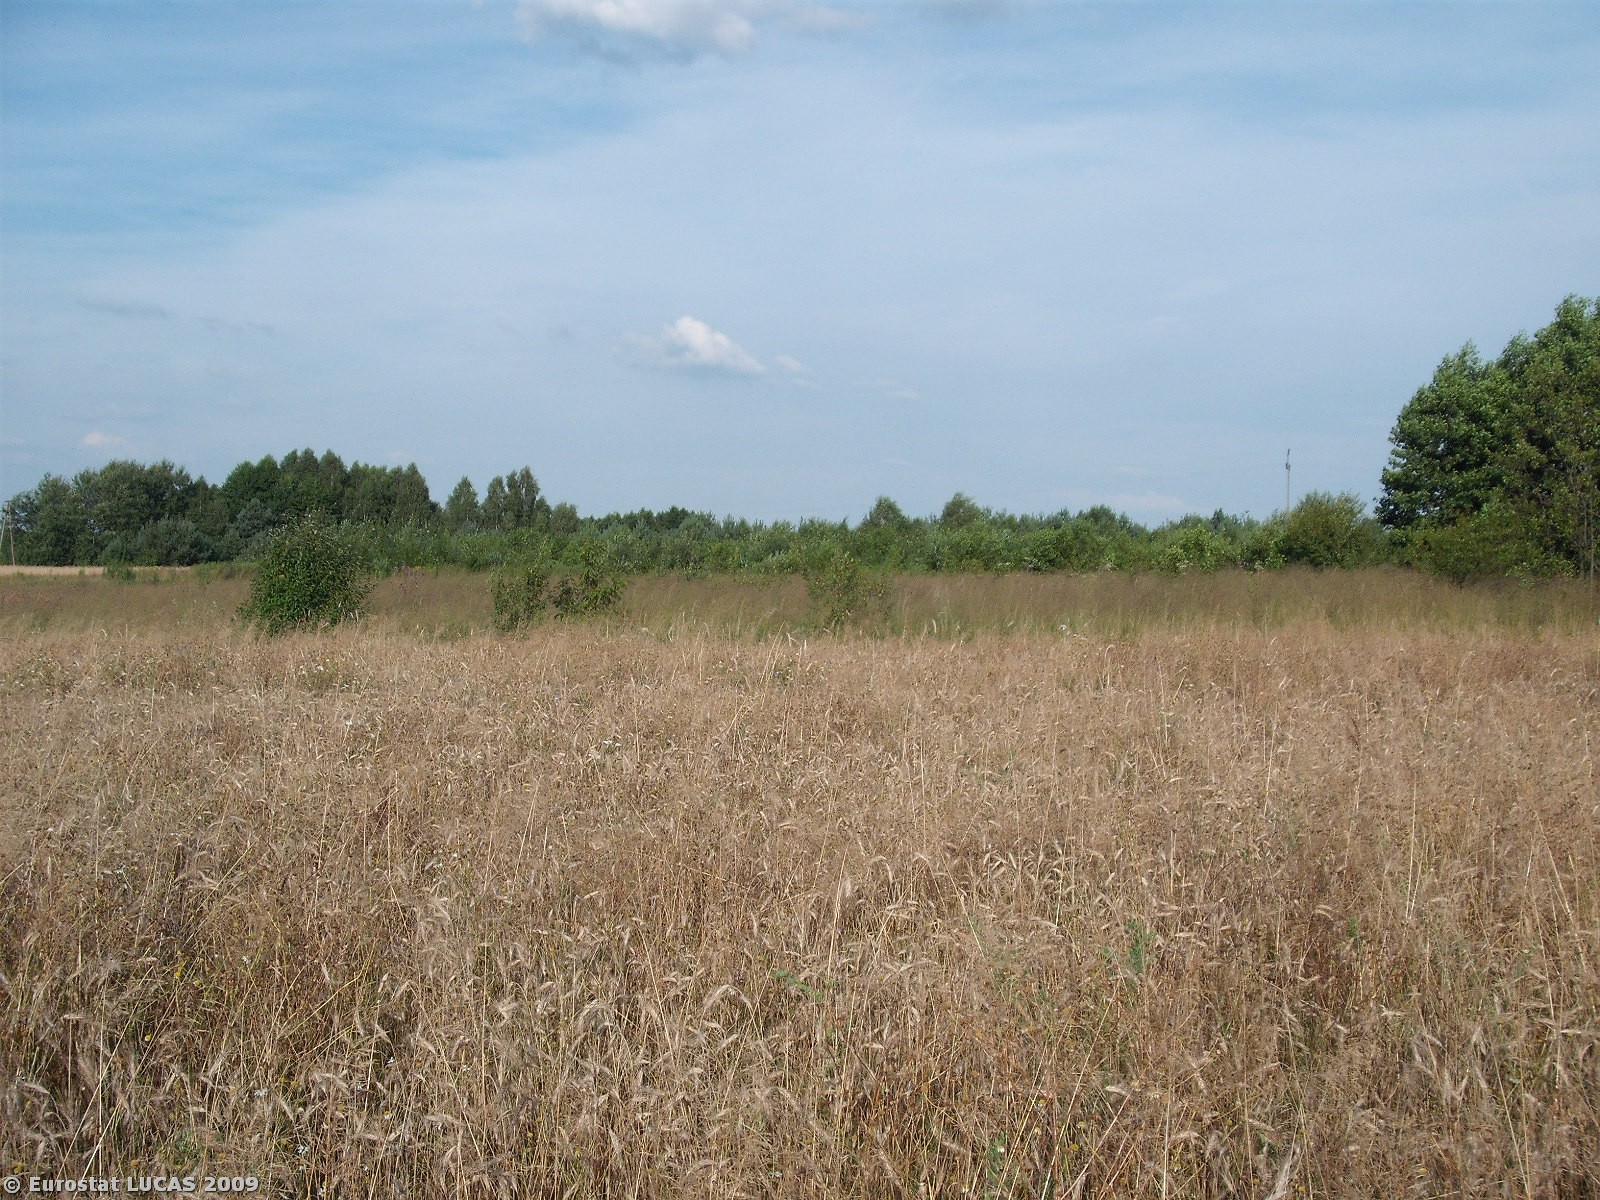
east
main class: Cropland
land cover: Triticale
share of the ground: > 75 %
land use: Agriculture (excluding fallow land and kitchen gardens)
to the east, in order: Triticale; Grass margins; Rye; Tracks; Grassland with sparse tree/shrub cover; Triticale; Tracks; Grassland without tree/shrub cover; Broadleaved woodland; Grassland without tree/shrub cover; Rye; Electric lines; Rye; Coniferous woodland; Grassland without tree/shrub cover
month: July
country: PL
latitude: 50.5648
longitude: 21.2998
